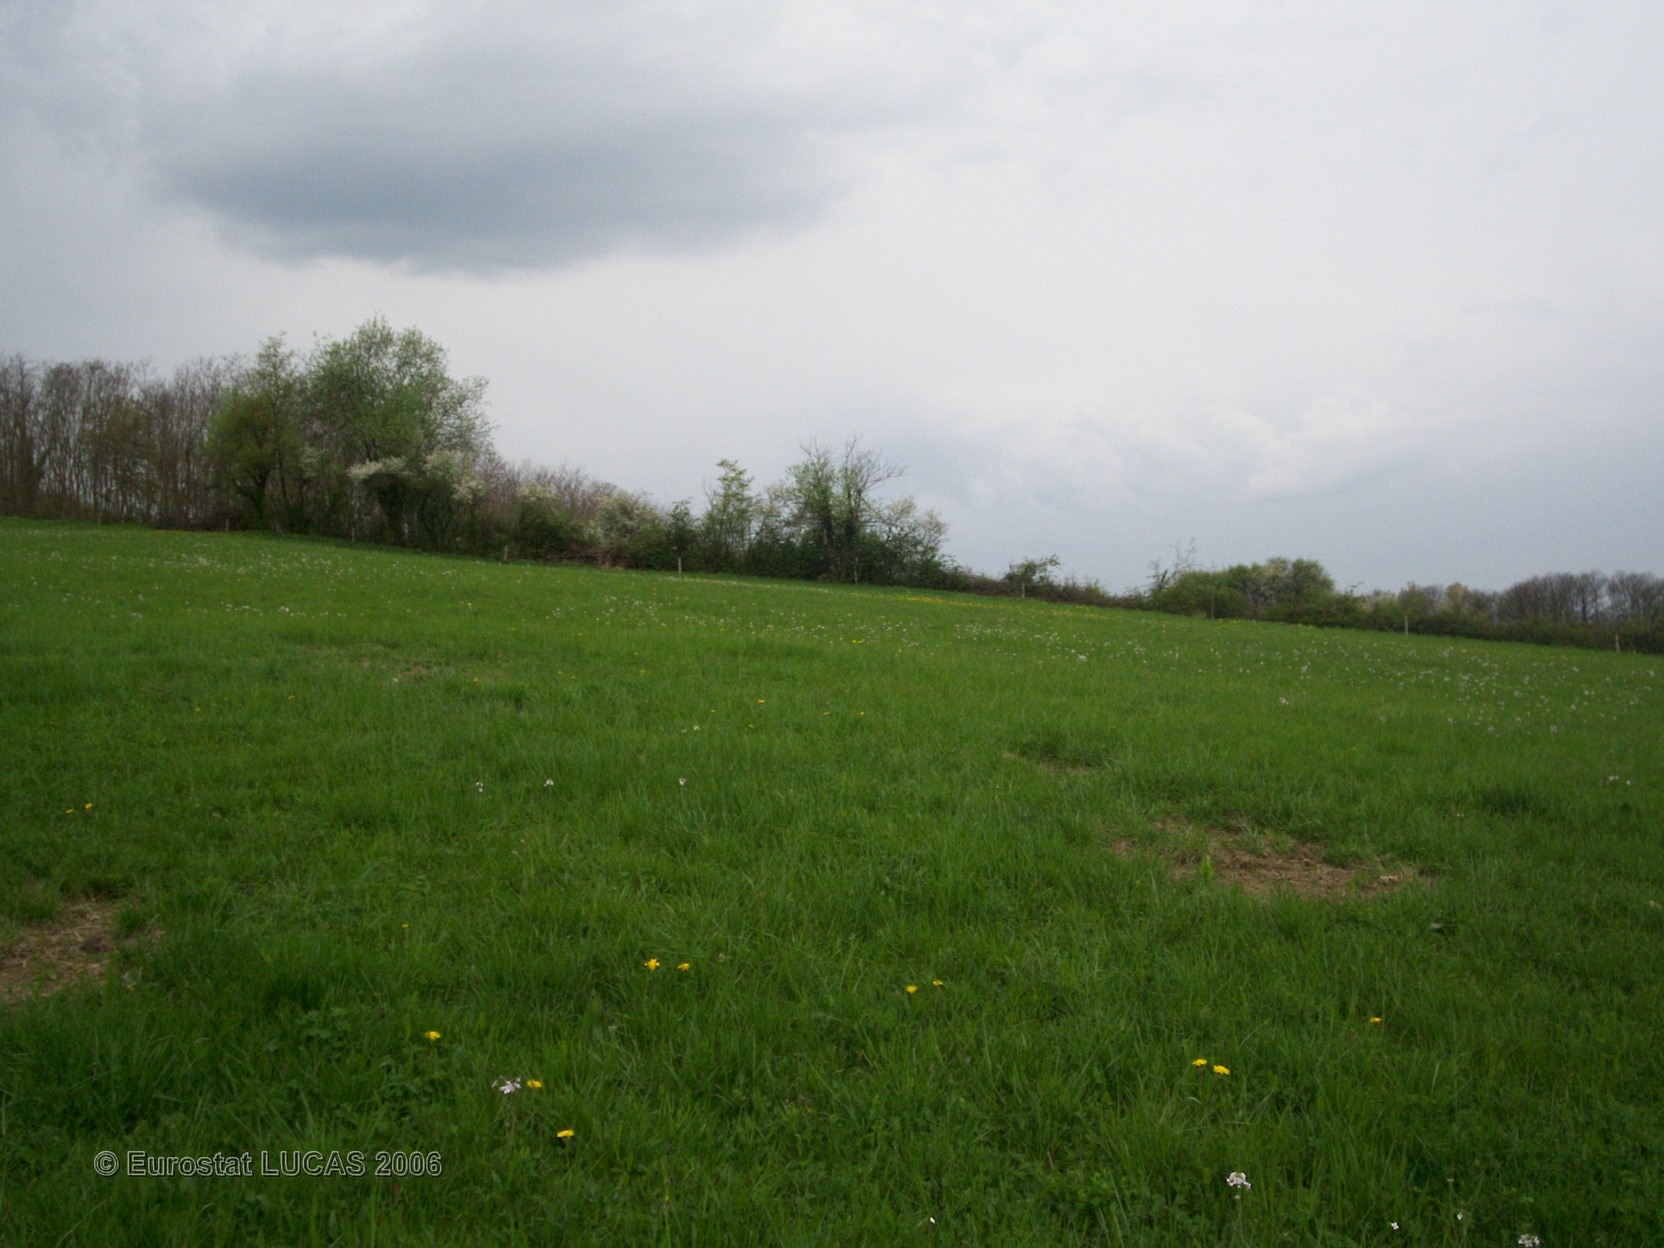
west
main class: Grassland
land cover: Grassland without tree/shrub cover
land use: Agriculture (excluding fallow land and kitchen gardens)
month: April
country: FR
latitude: 46.8317
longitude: 4.6651
